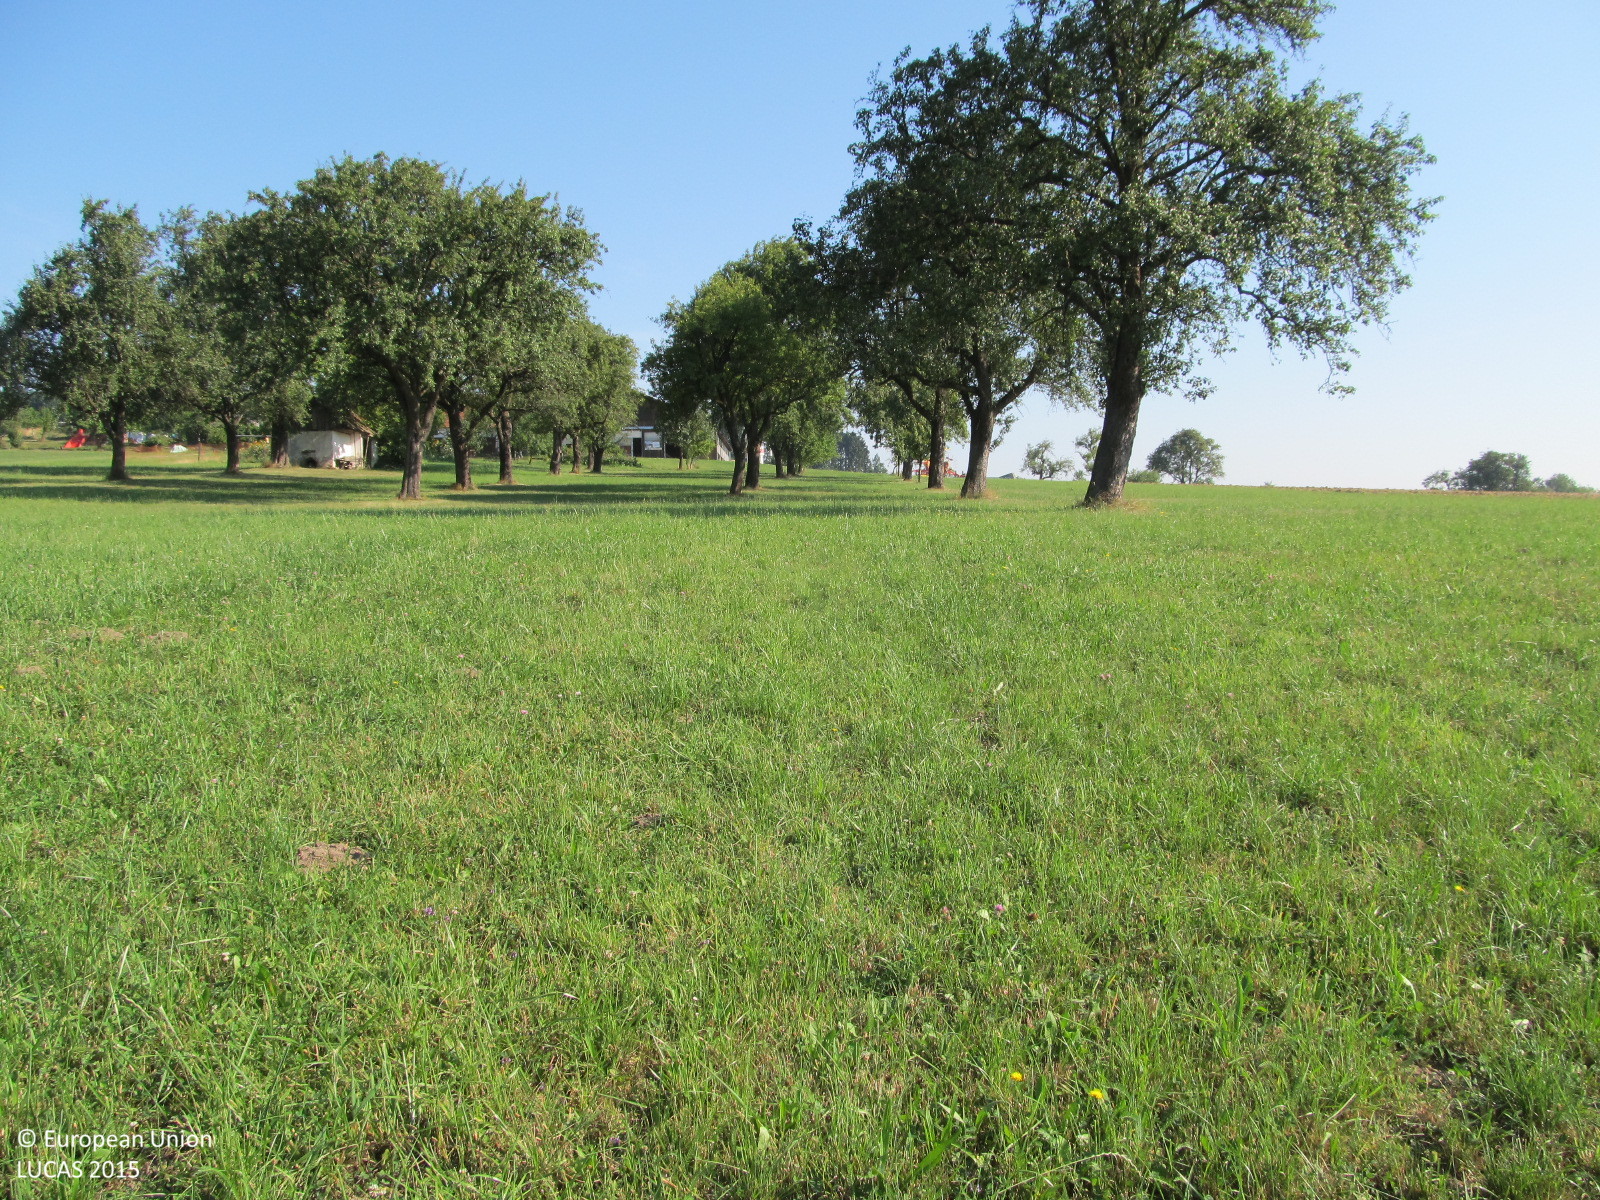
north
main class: Grassland
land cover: Grassland without tree/shrub cover
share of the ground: > 75 %
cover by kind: herbaceous plants 100 %
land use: Agriculture (excluding fallow land and kitchen gardens)
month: August
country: AT
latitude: 48.1171
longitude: 15.6040
